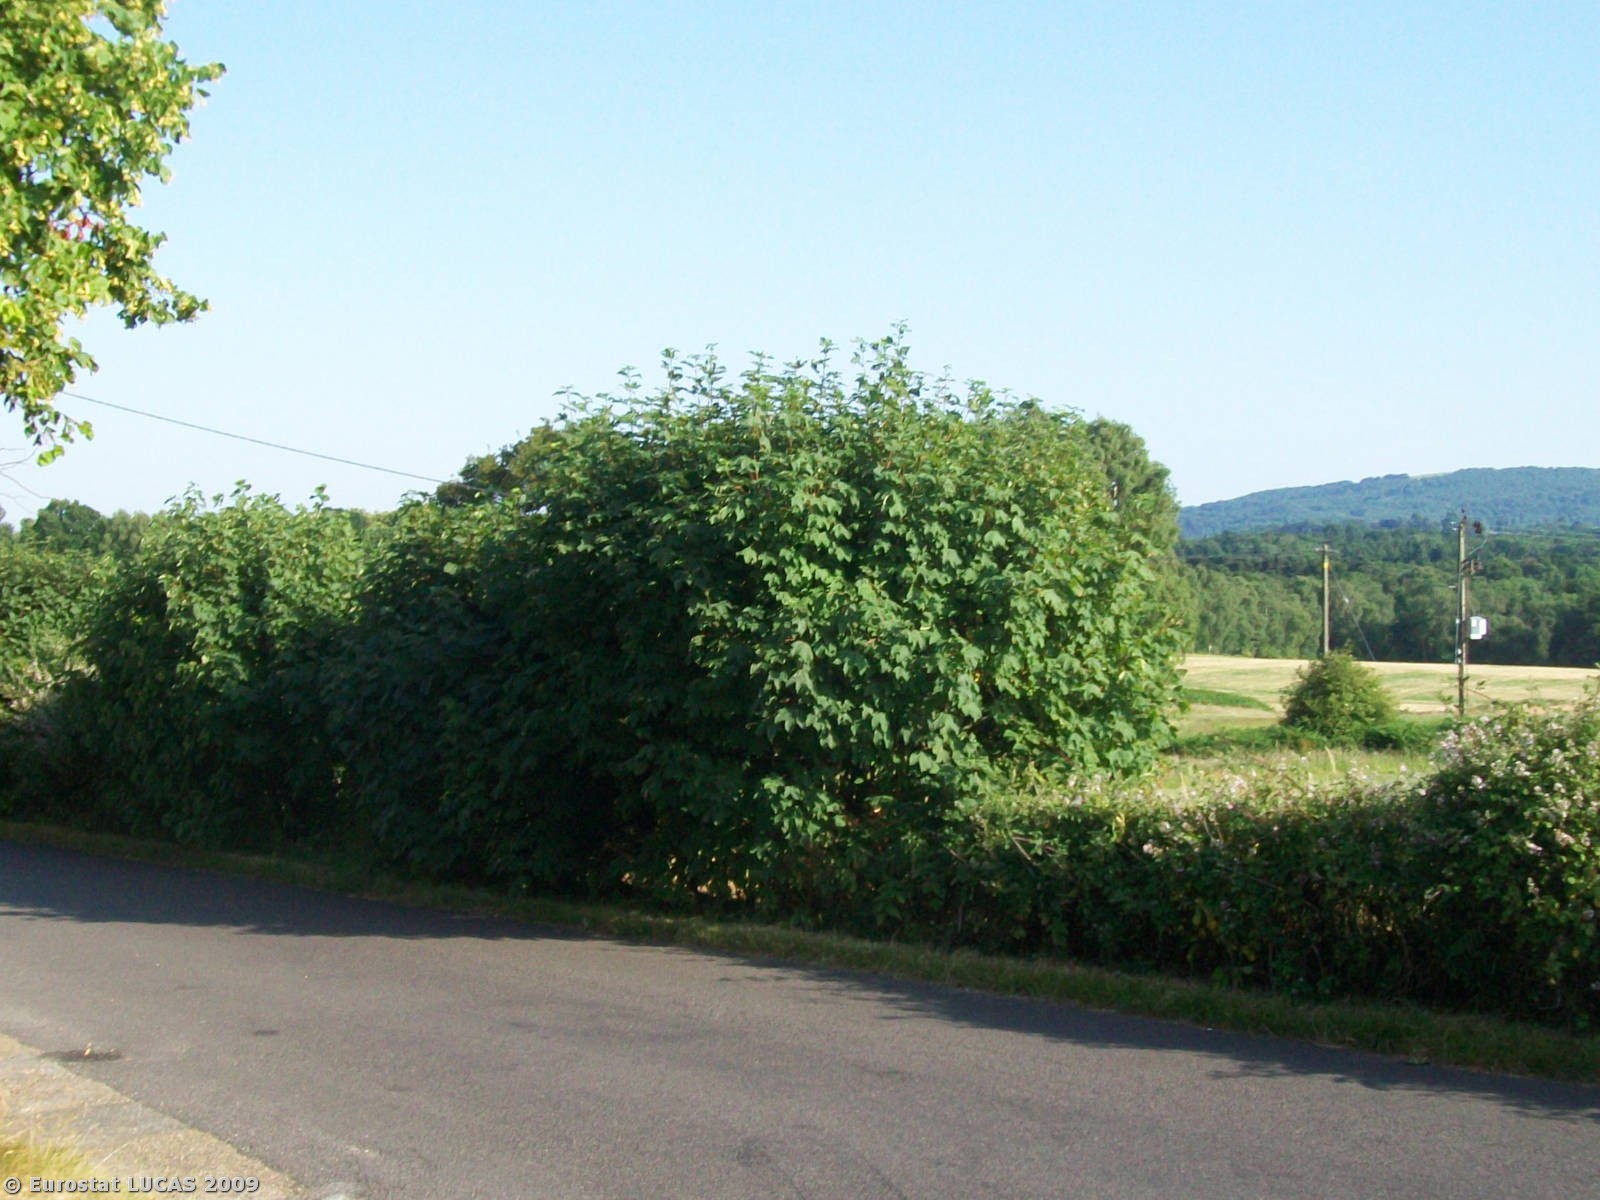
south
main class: Grassland
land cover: Grassland without tree/shrub cover
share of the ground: > 75 %
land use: Agriculture (excluding fallow land and kitchen gardens)
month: June
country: GB
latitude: 50.9567
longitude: -0.6173
